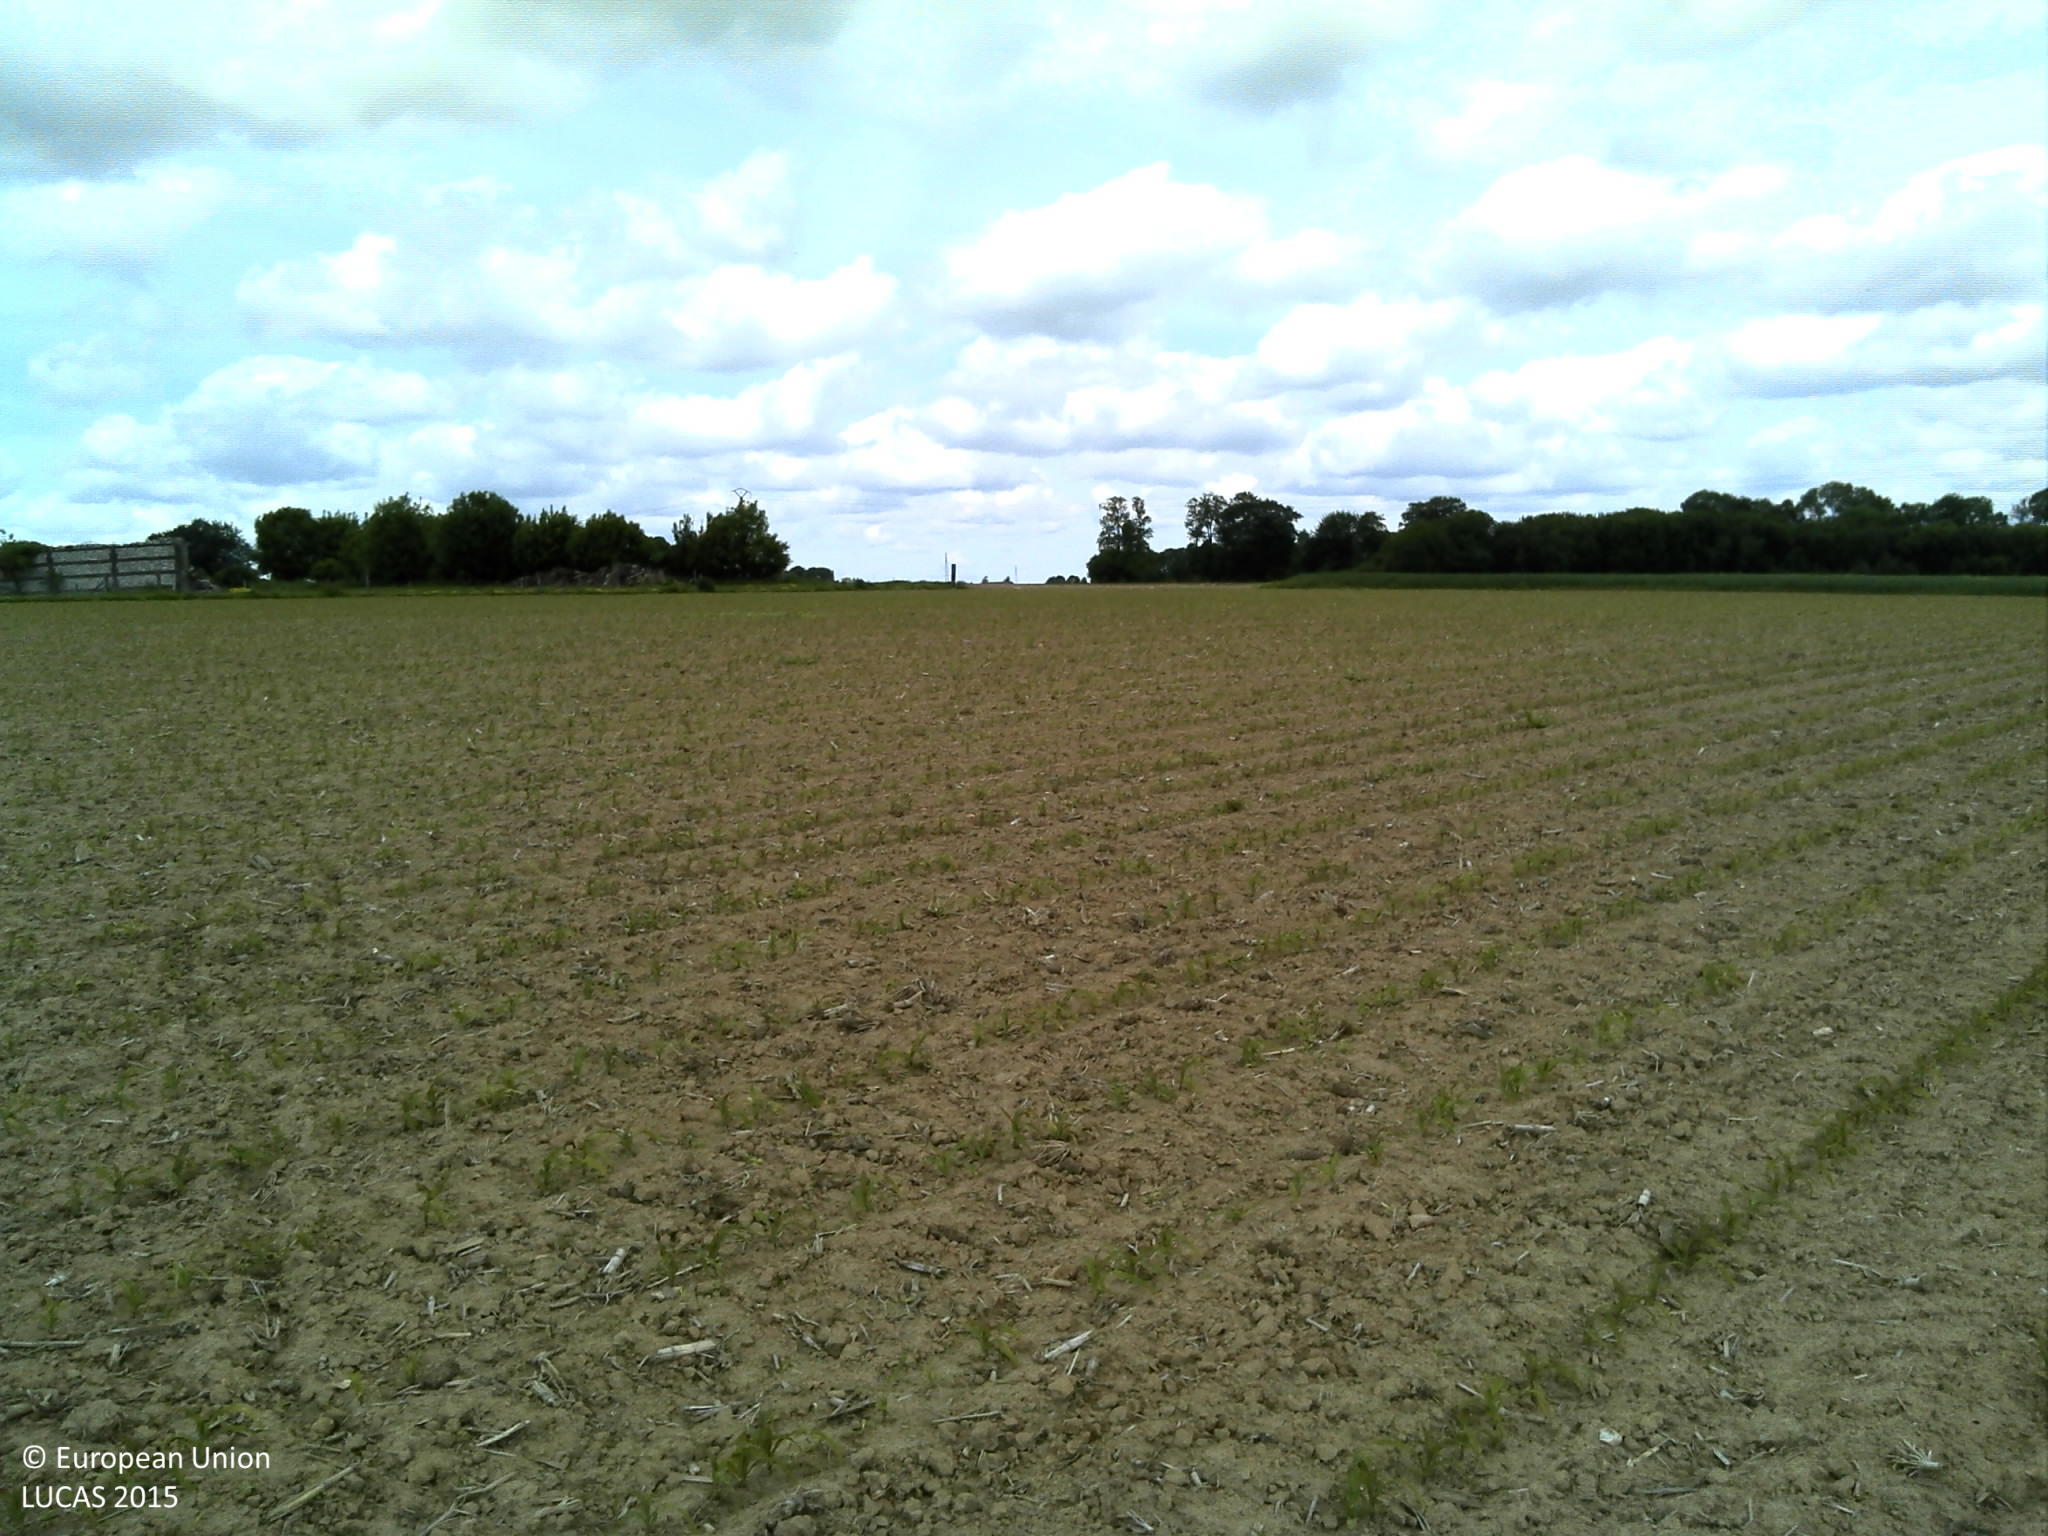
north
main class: Cropland
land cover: Maize
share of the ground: < 10 %
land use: Agriculture (excluding fallow land and kitchen gardens)
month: May
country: FR
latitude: 49.5230
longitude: 0.5941
